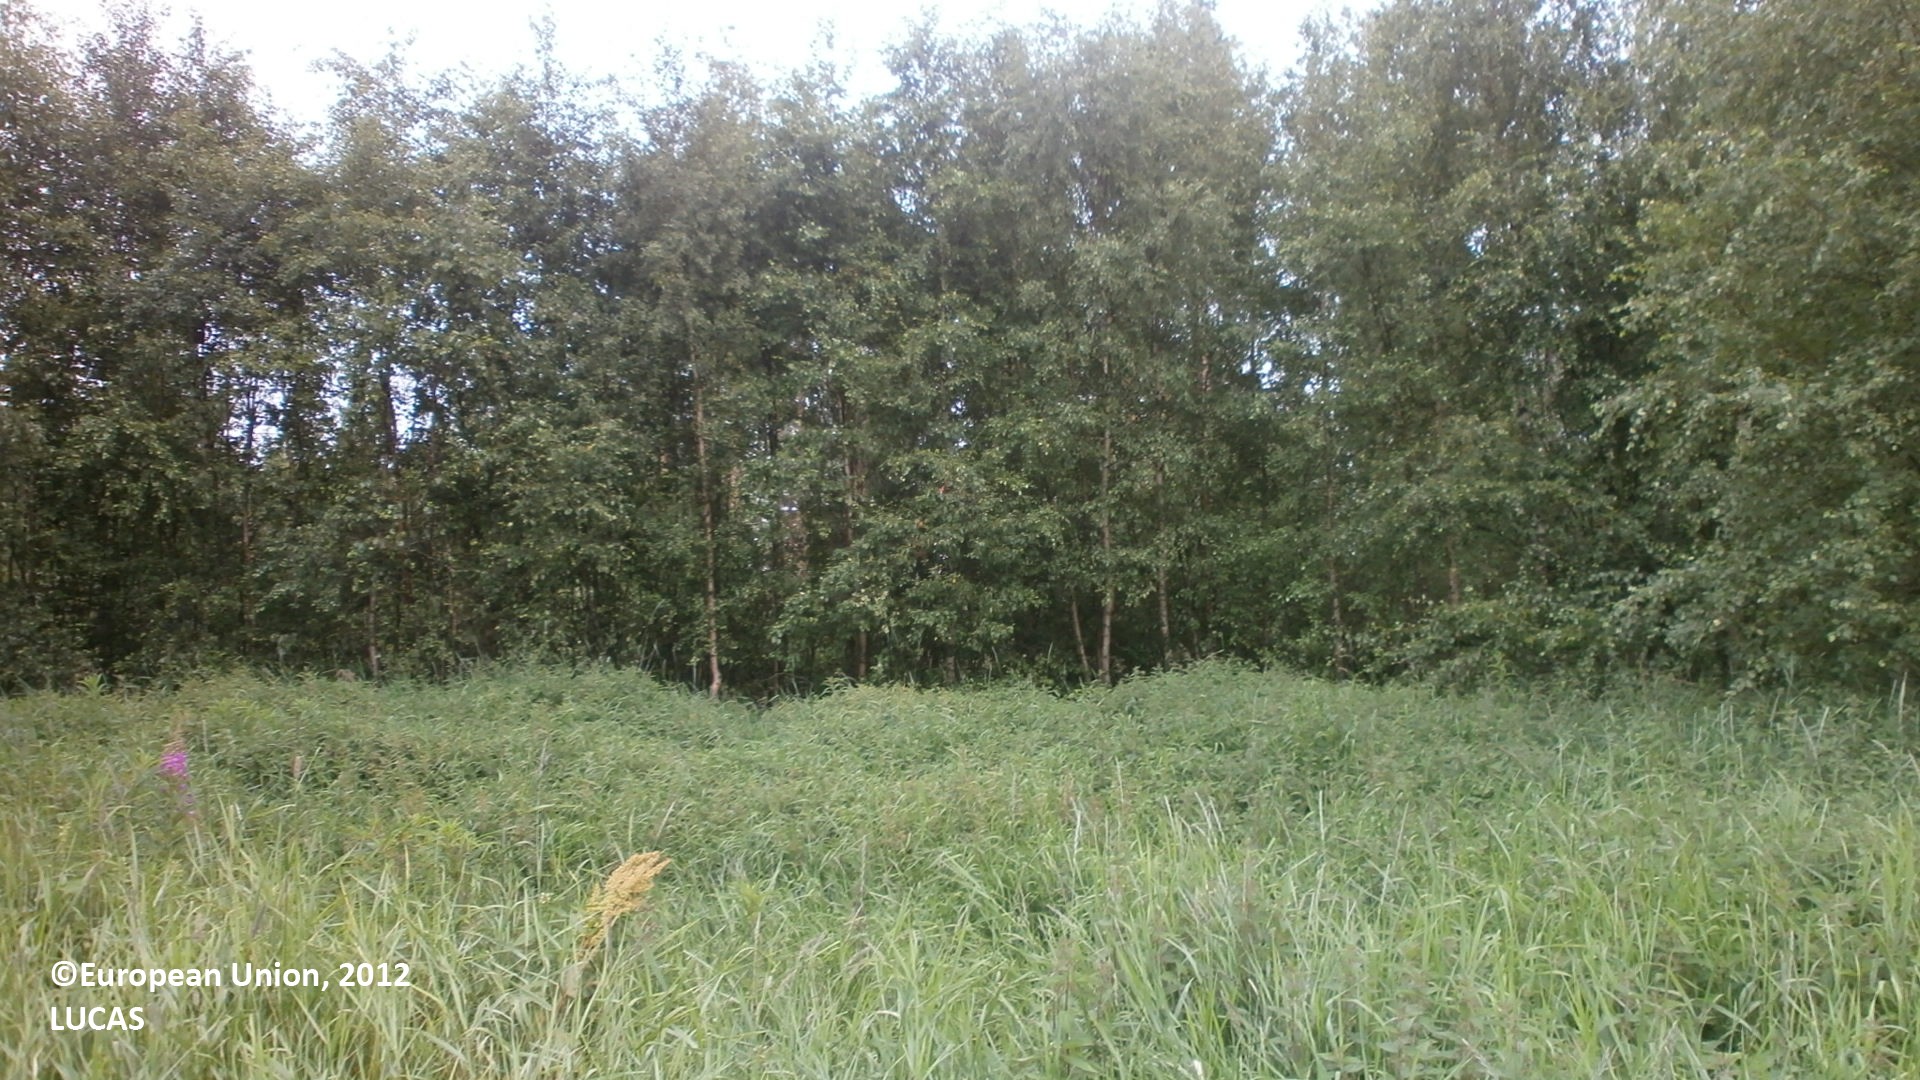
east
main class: Cropland
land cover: Barley
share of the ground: > 75 %
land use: Agriculture (excluding fallow land and kitchen gardens)
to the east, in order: Barley; Spontaneously vegetated surfaces; Broadleaved woodland; Pine dominated coniferous woodland; Pine dominated mixed woodland
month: July
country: FI
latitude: 64.2282
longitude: 24.0610
